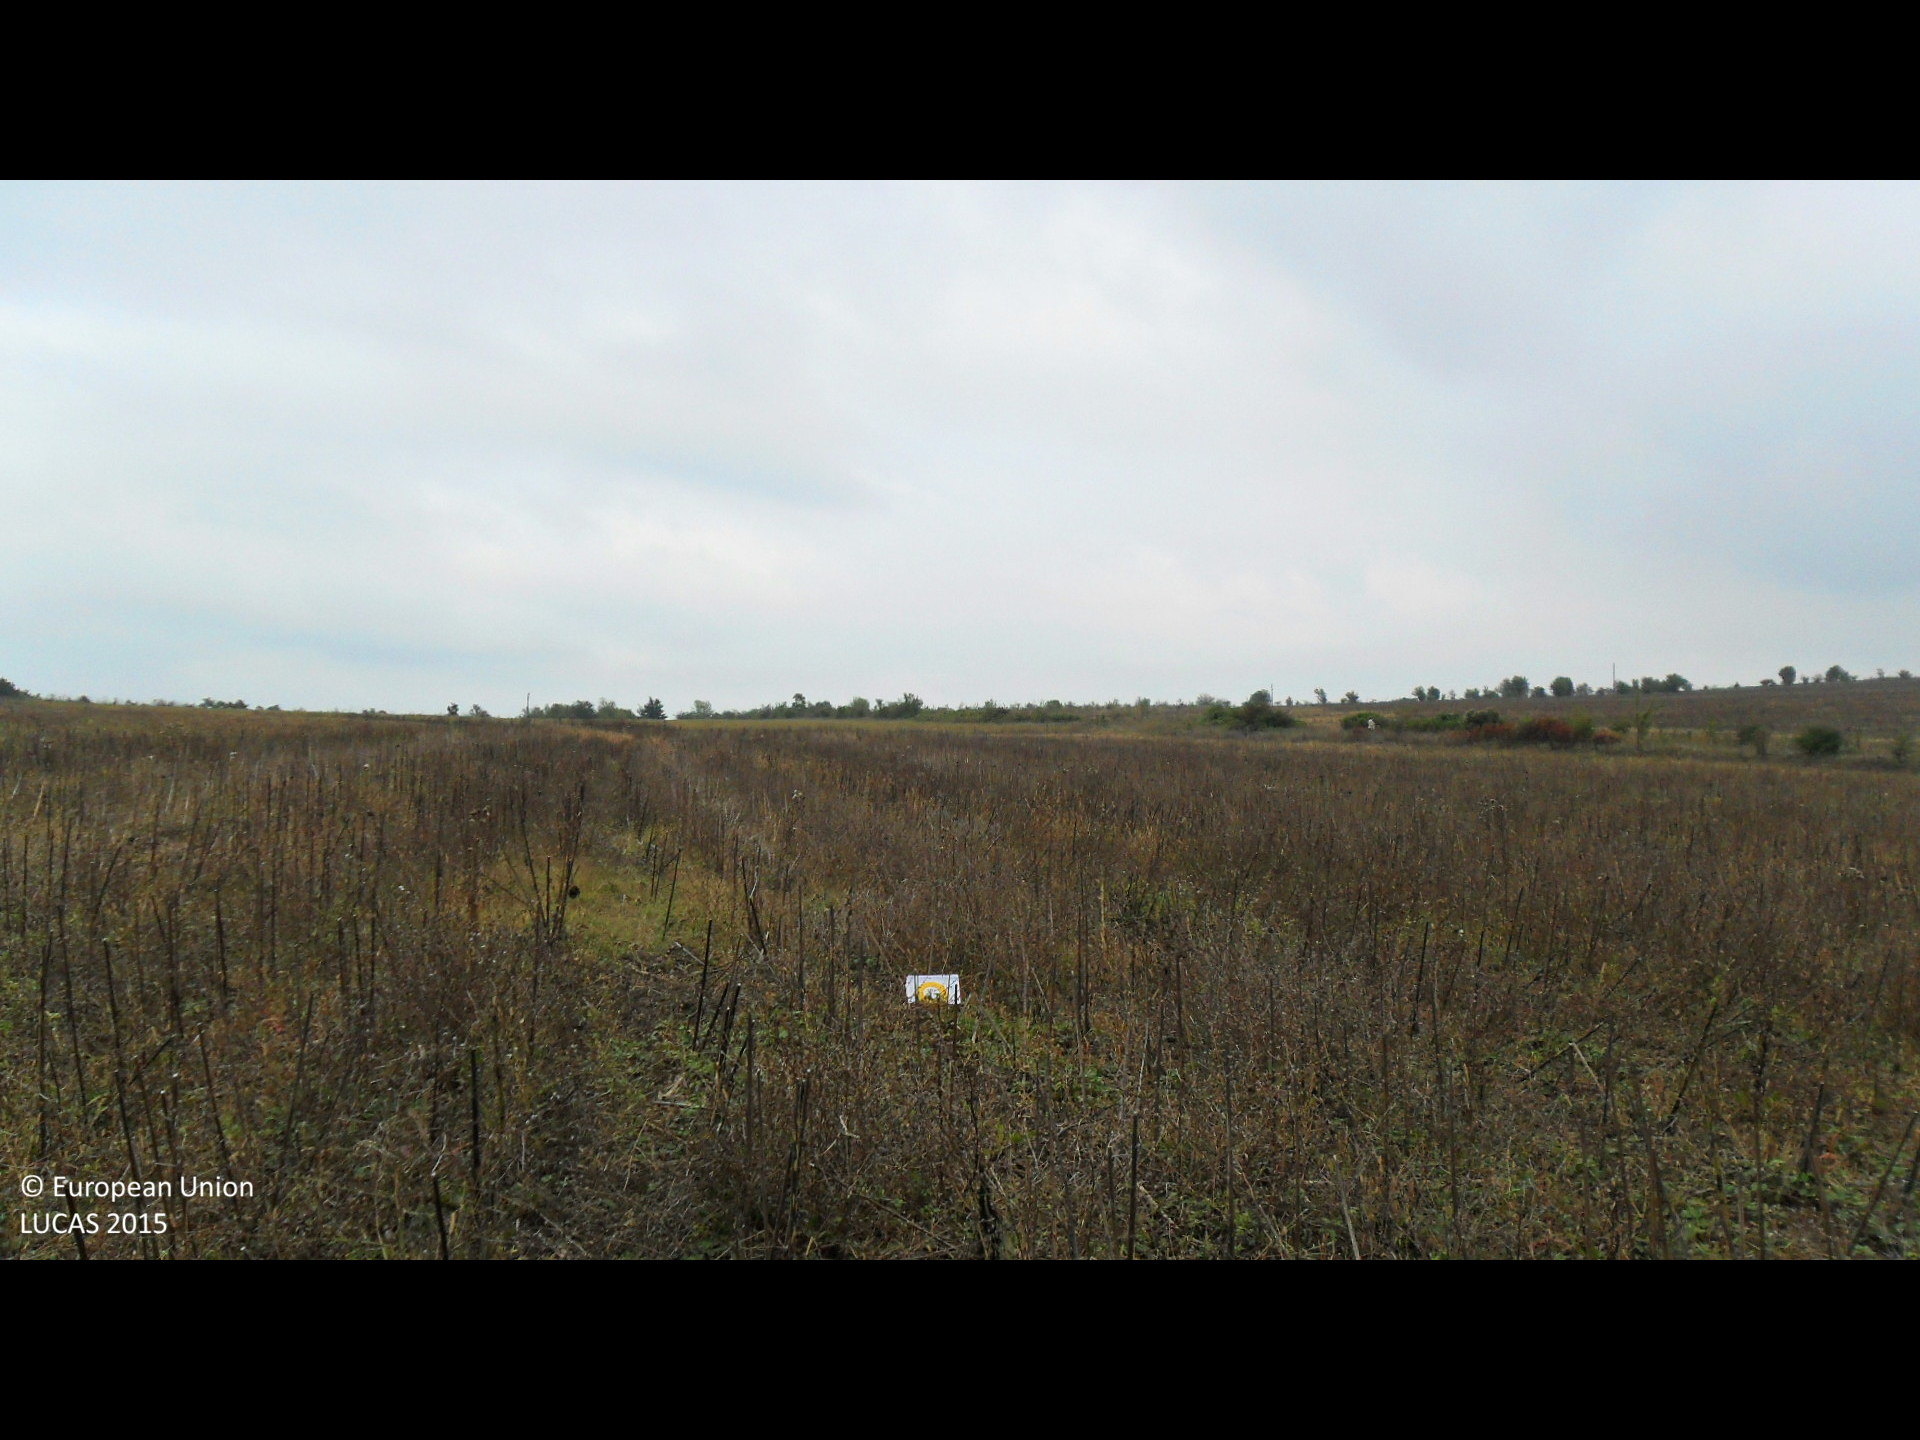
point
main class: Cropland
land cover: Sunflower
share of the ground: 10 - 25 %
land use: Agriculture (excluding fallow land and kitchen gardens)
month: September
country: BG
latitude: 43.1488
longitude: 26.2646
